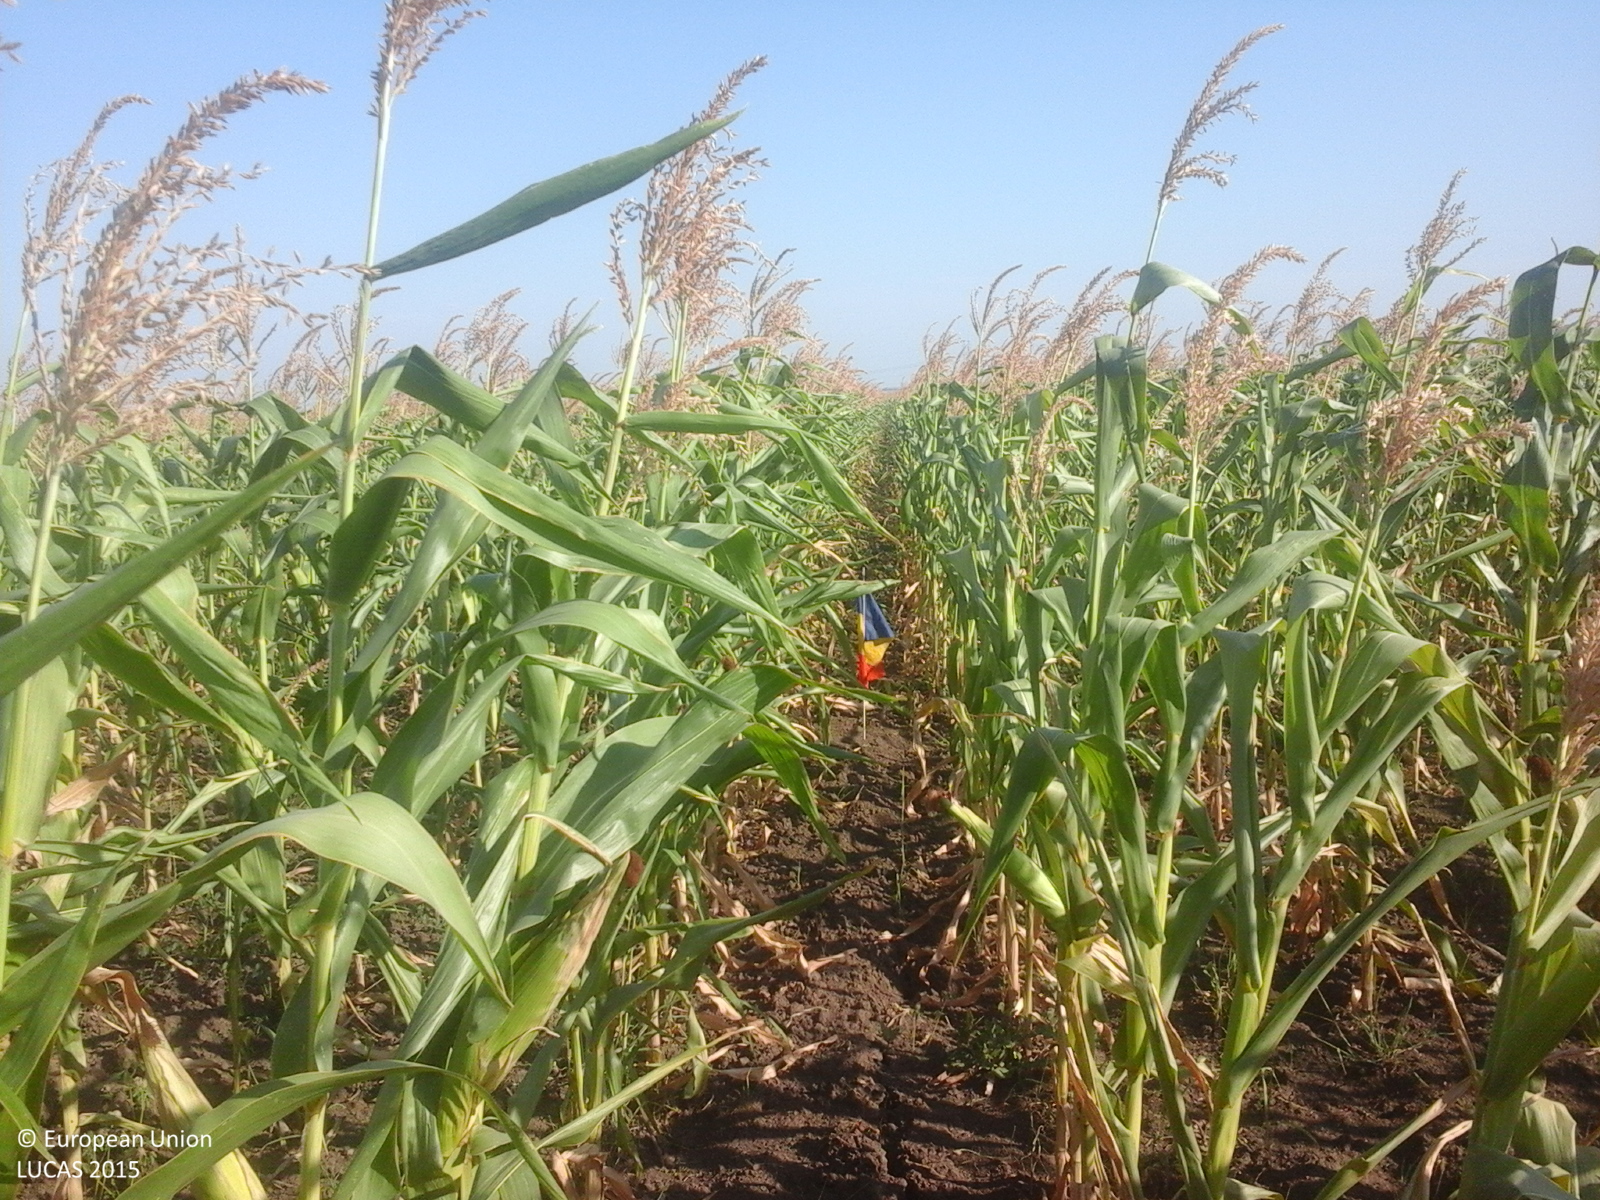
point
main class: Cropland
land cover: Maize
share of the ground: > 75 %
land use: Agriculture (excluding fallow land and kitchen gardens)
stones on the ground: < 10 %
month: August
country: RO
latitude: 45.0712
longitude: 26.6502
